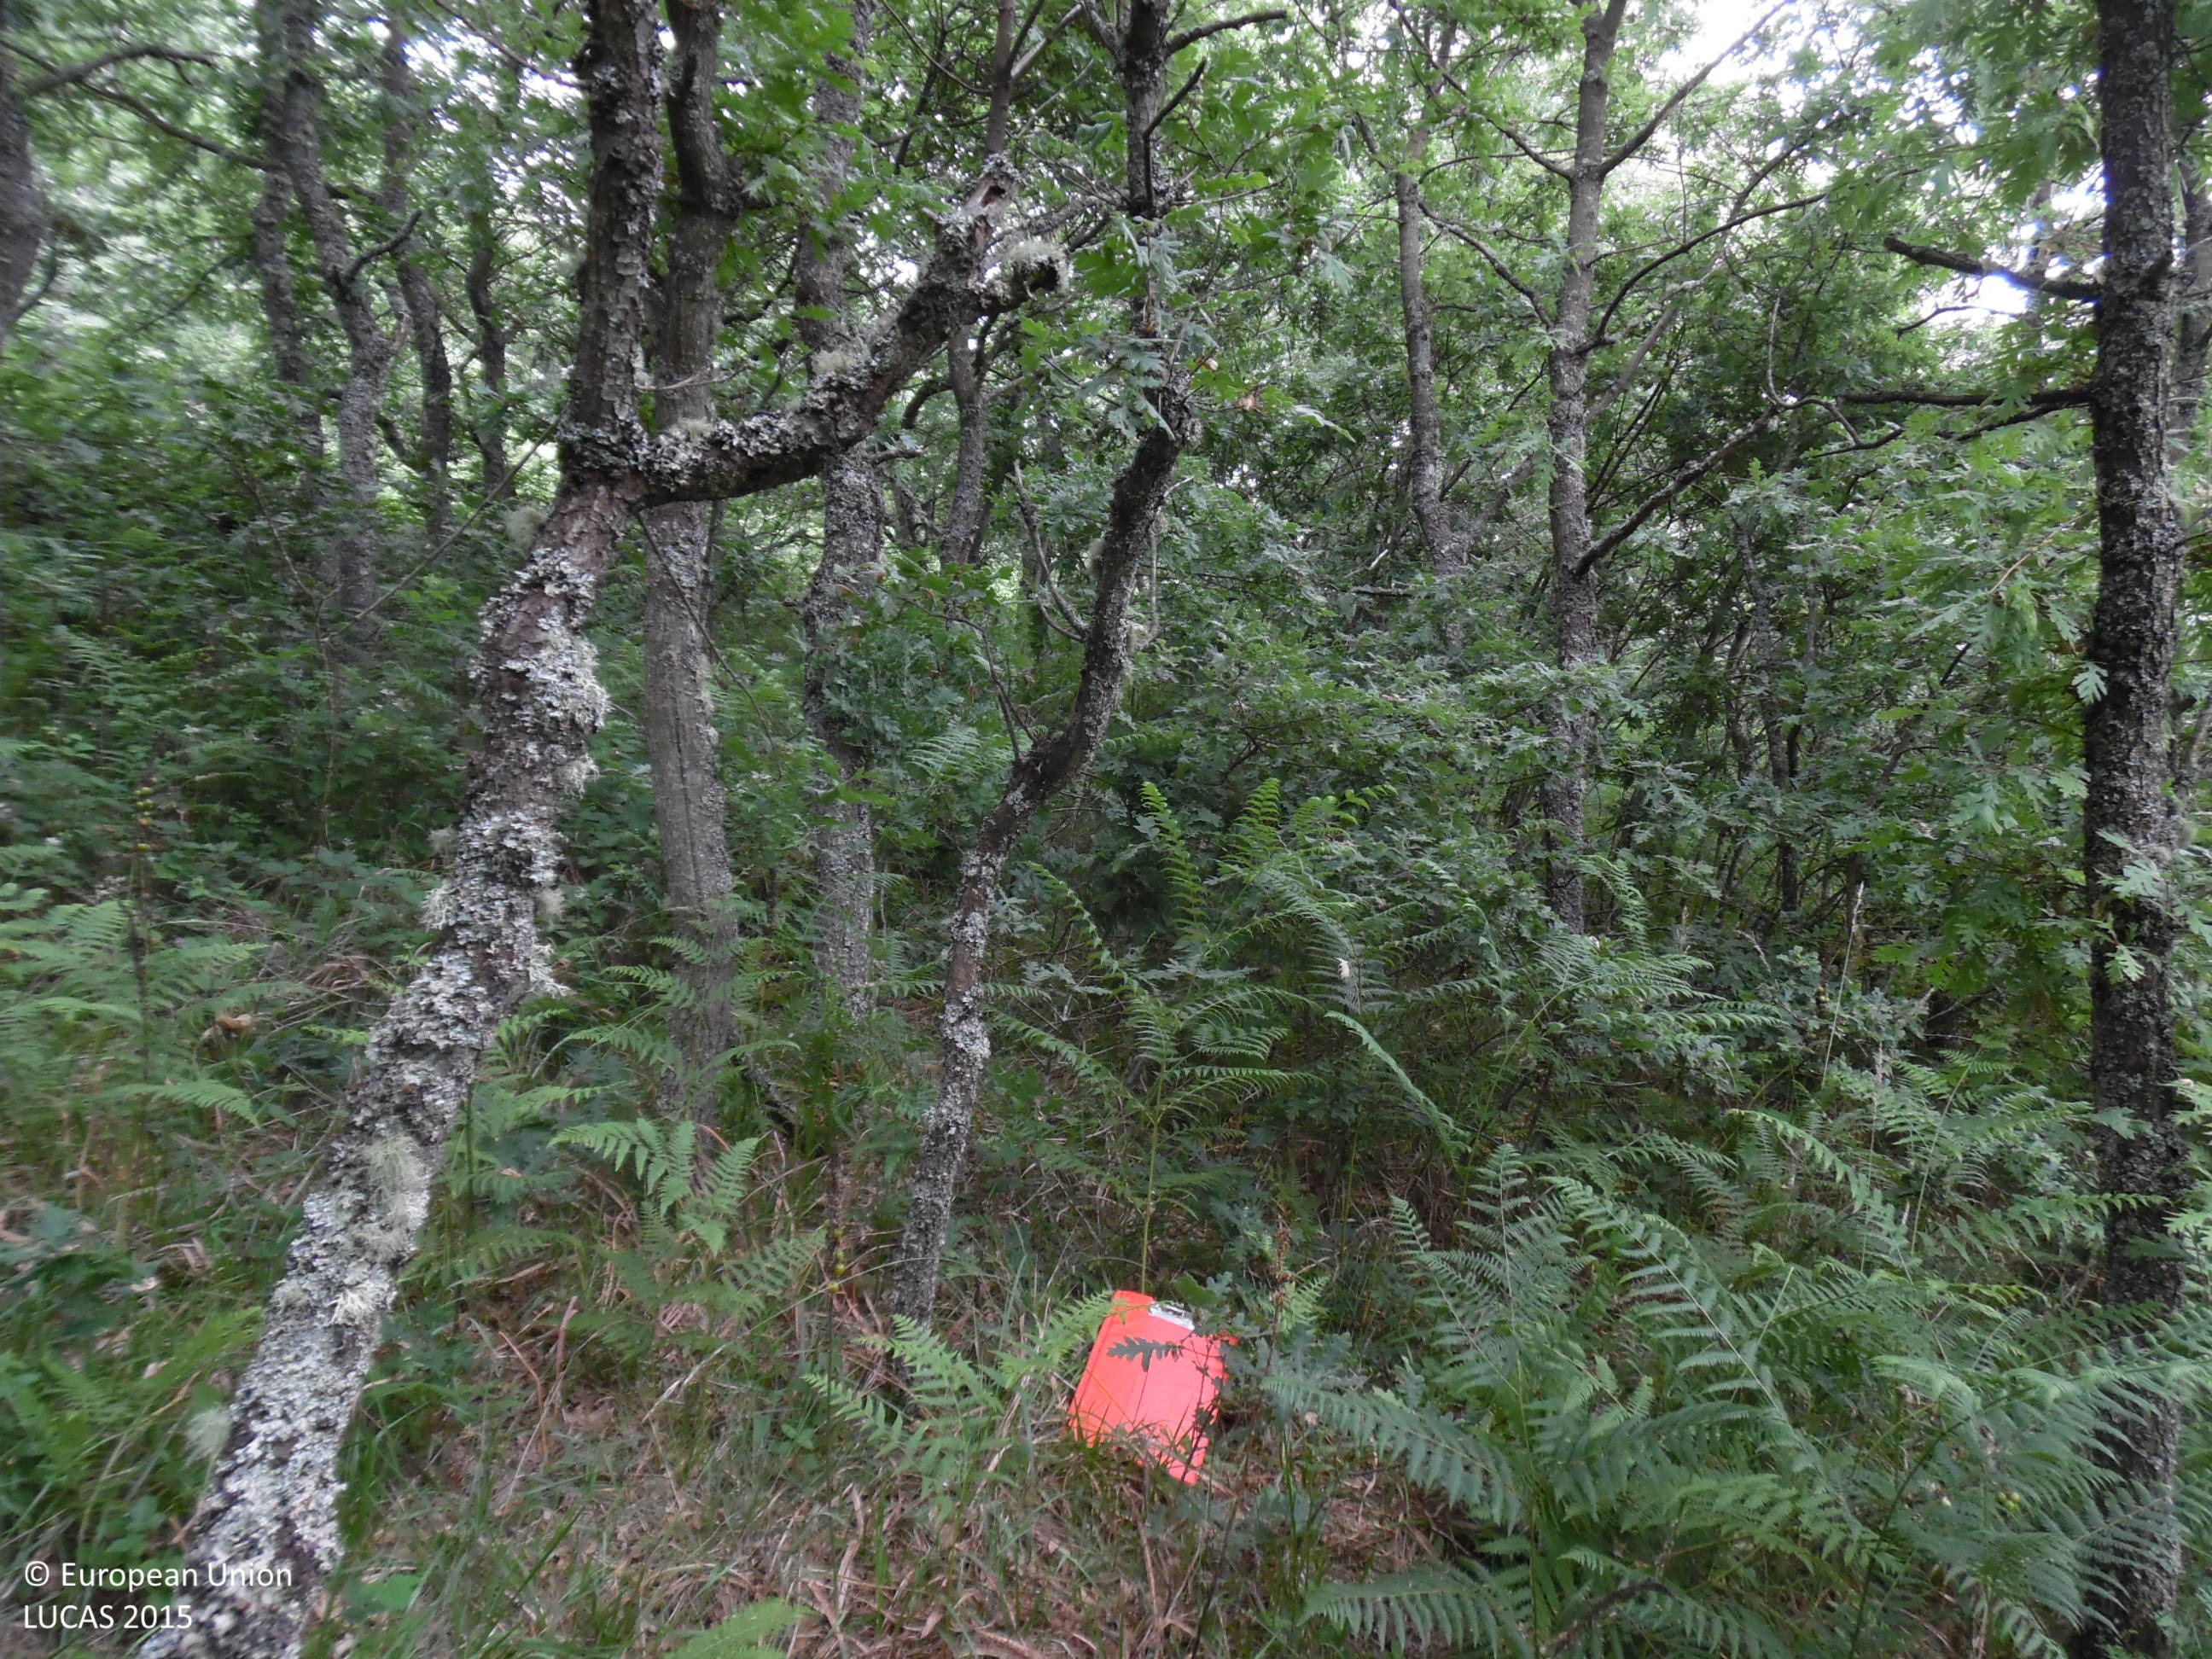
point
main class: Woodland
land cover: Broadleaved woodland
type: thermophilous deciduous forest
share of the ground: > 75 %
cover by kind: broadleaved forest trees 90 %, shrubs 5 %, consolidated bare surface 5 %
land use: Forestry
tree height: > 5 m
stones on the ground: < 10 %
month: July
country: ES
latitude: 43.1895
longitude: -6.5787
